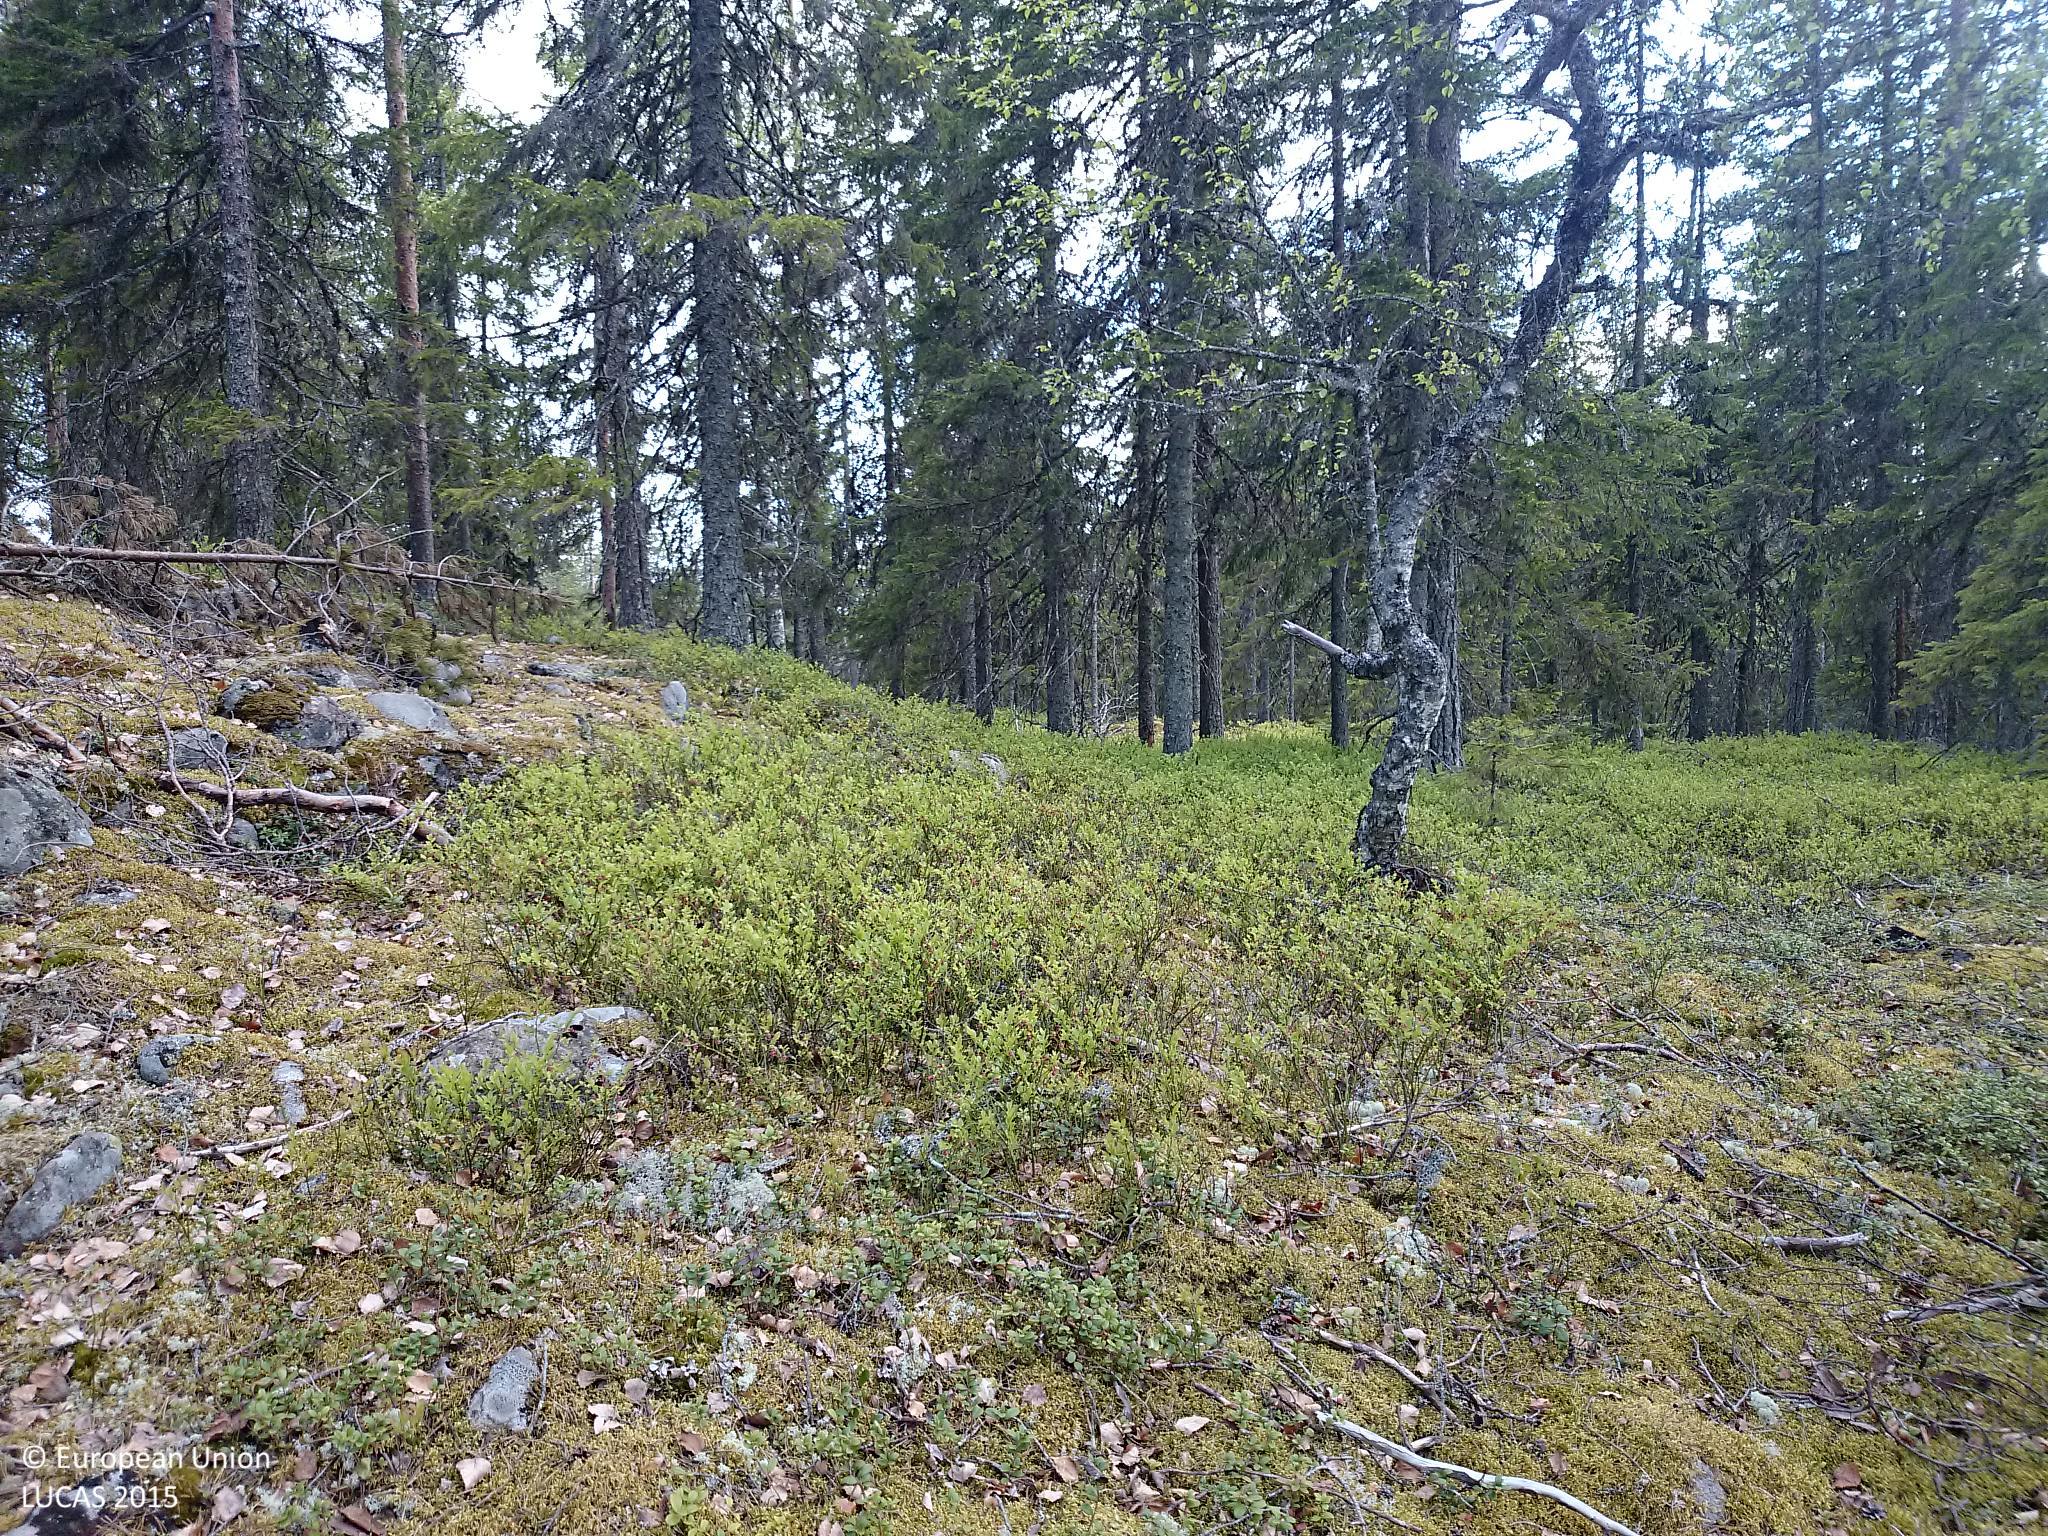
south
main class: Woodland
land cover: Other coniferous woodland
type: boreal forest
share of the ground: 25 - 50 %
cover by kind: coniferous forest trees 50 %, shrubs 40 %, lichens and mosses 5 %, consolidated bare surface 5 %
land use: Forestry
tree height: > 5 m
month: June
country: SE
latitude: 64.1451
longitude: 20.1517
